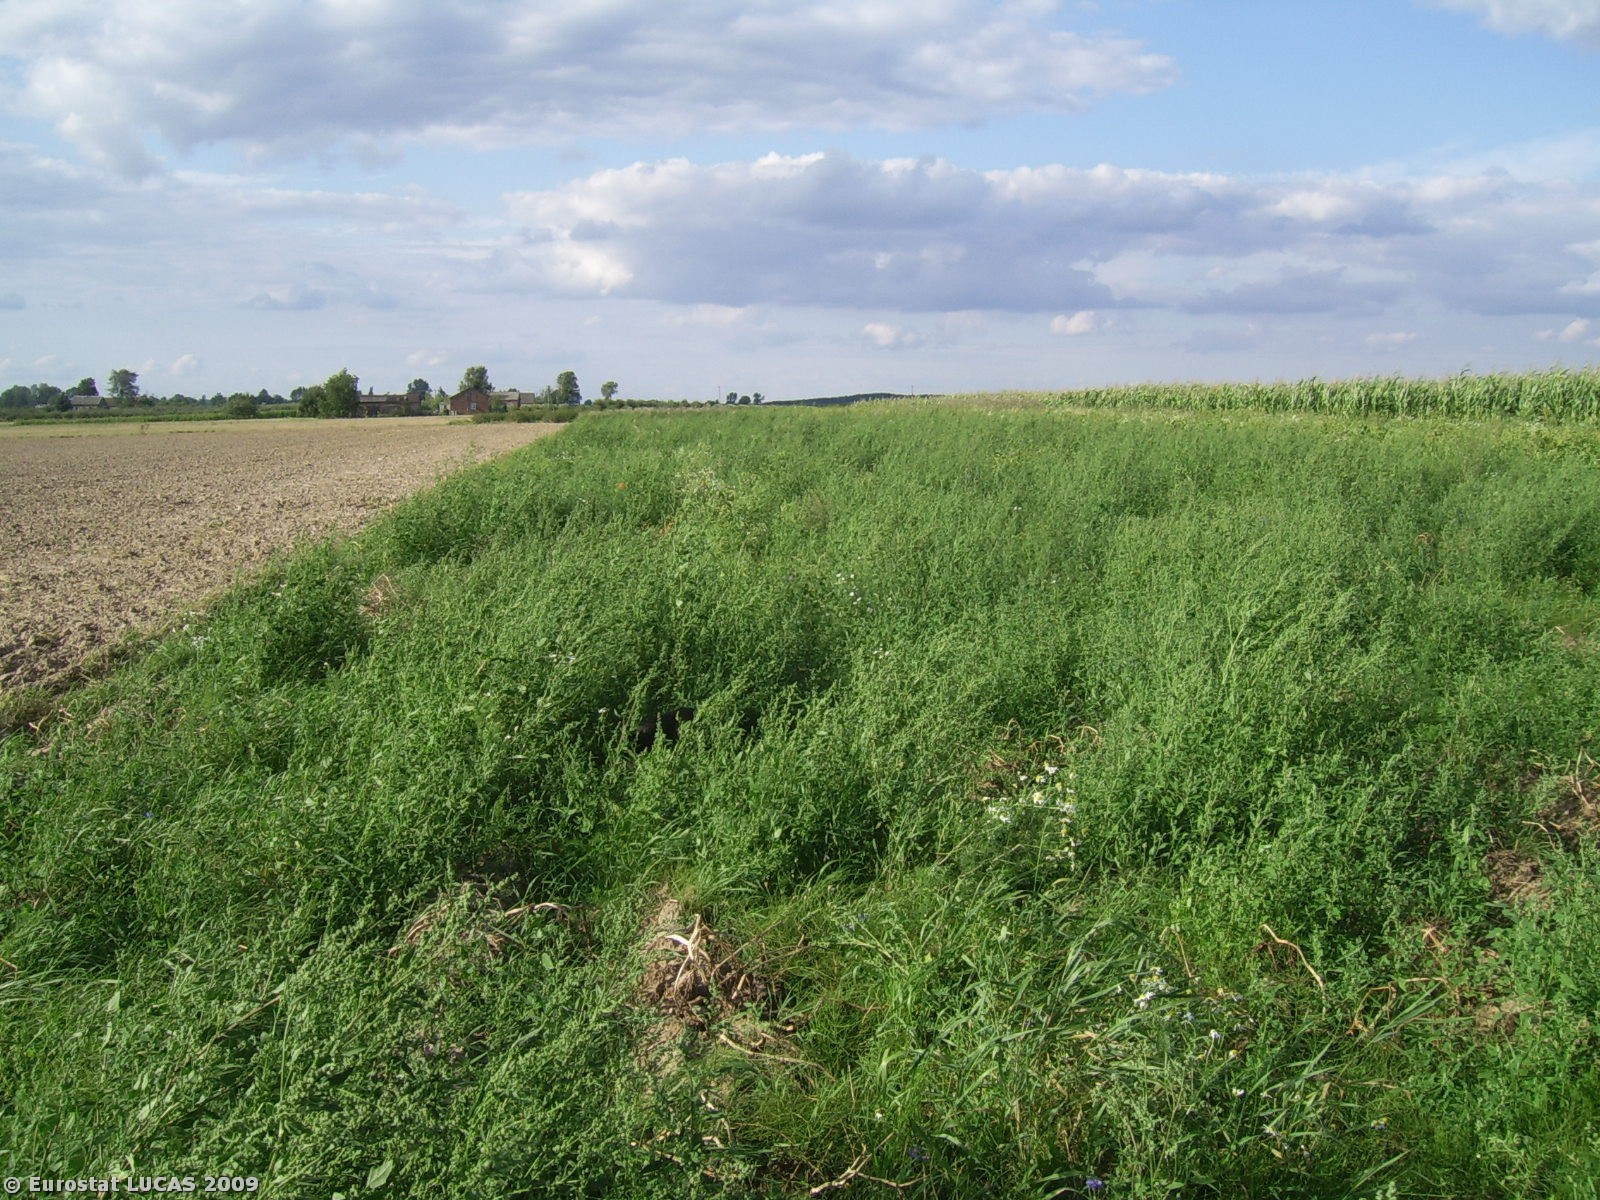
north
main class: Cropland
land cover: Potatoes
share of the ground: > 75 %
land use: Agriculture (excluding fallow land and kitchen gardens)
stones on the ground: < 10 %
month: August
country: PL
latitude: 52.3736
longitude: 18.5832
